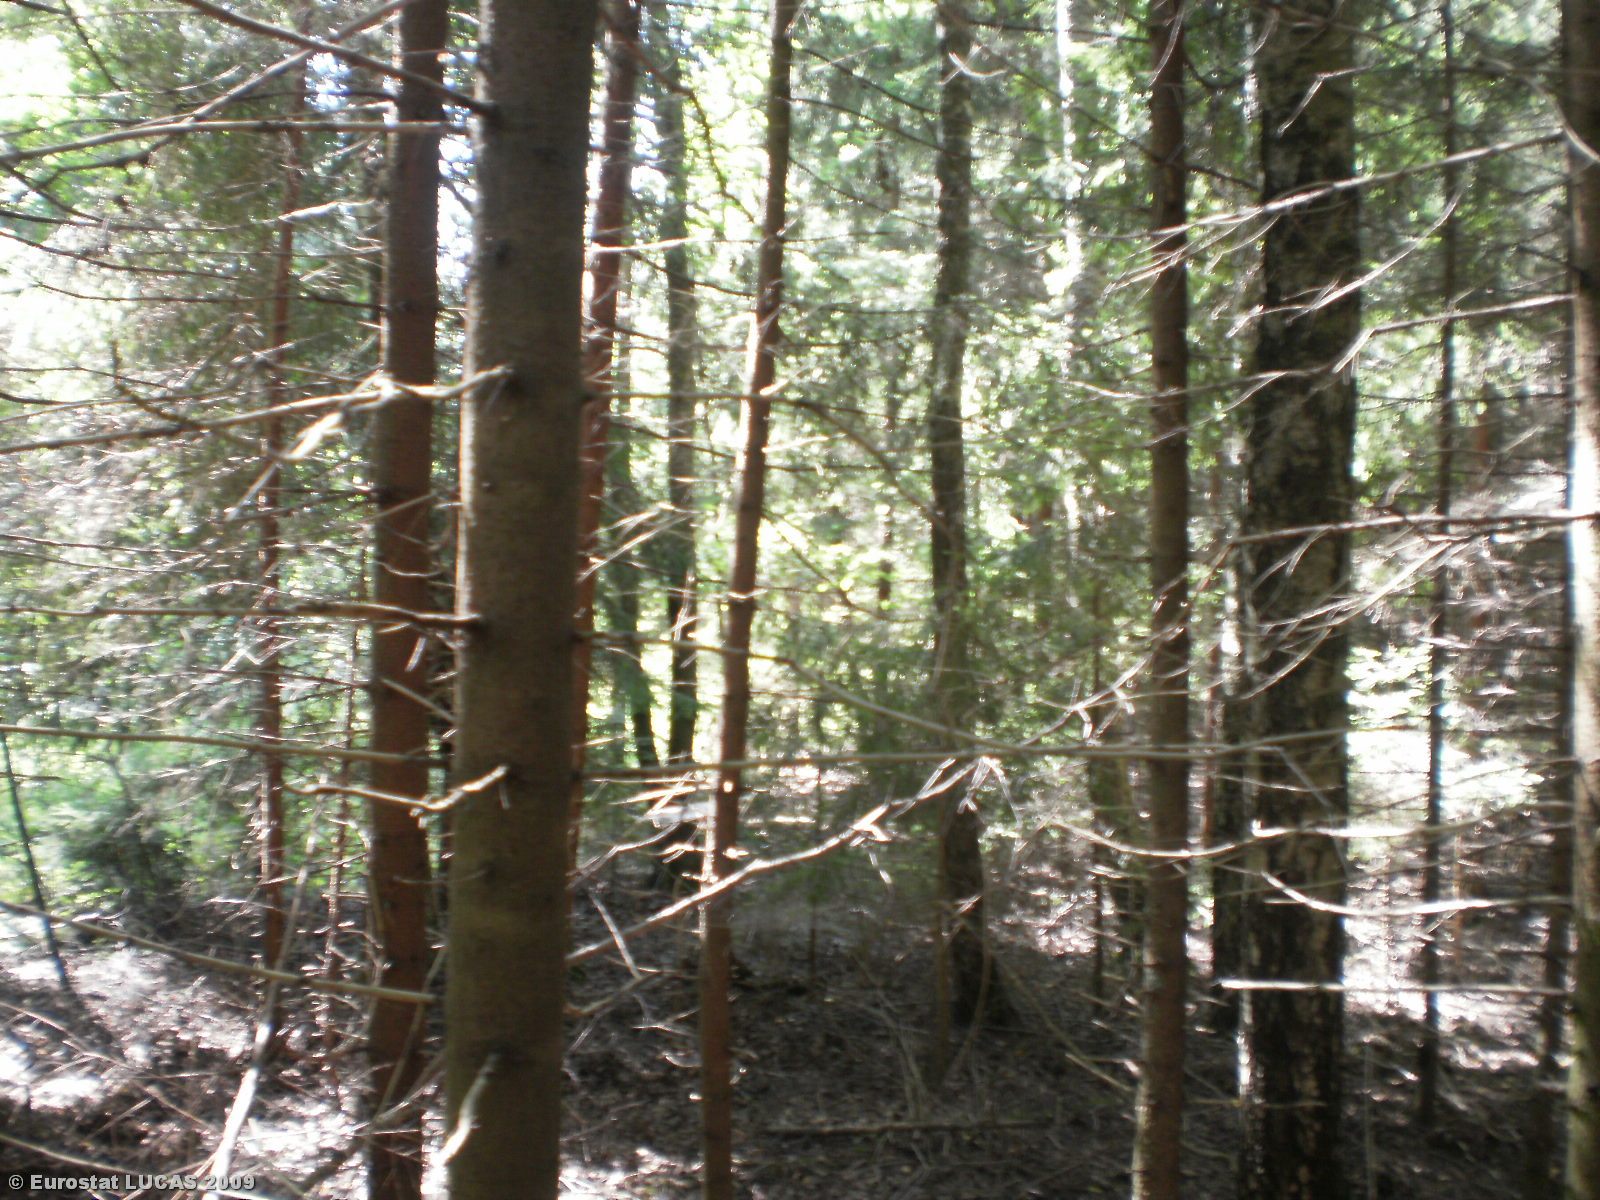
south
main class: Woodland
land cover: Coniferous woodland
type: hemiboreal forest and nemoral coniferous forest and mixed broadleaved-coniferous forest
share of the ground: > 75 %
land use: Forestry
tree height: > 5 m
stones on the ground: < 10 %
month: August
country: LT
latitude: 55.7507
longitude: 25.2037
